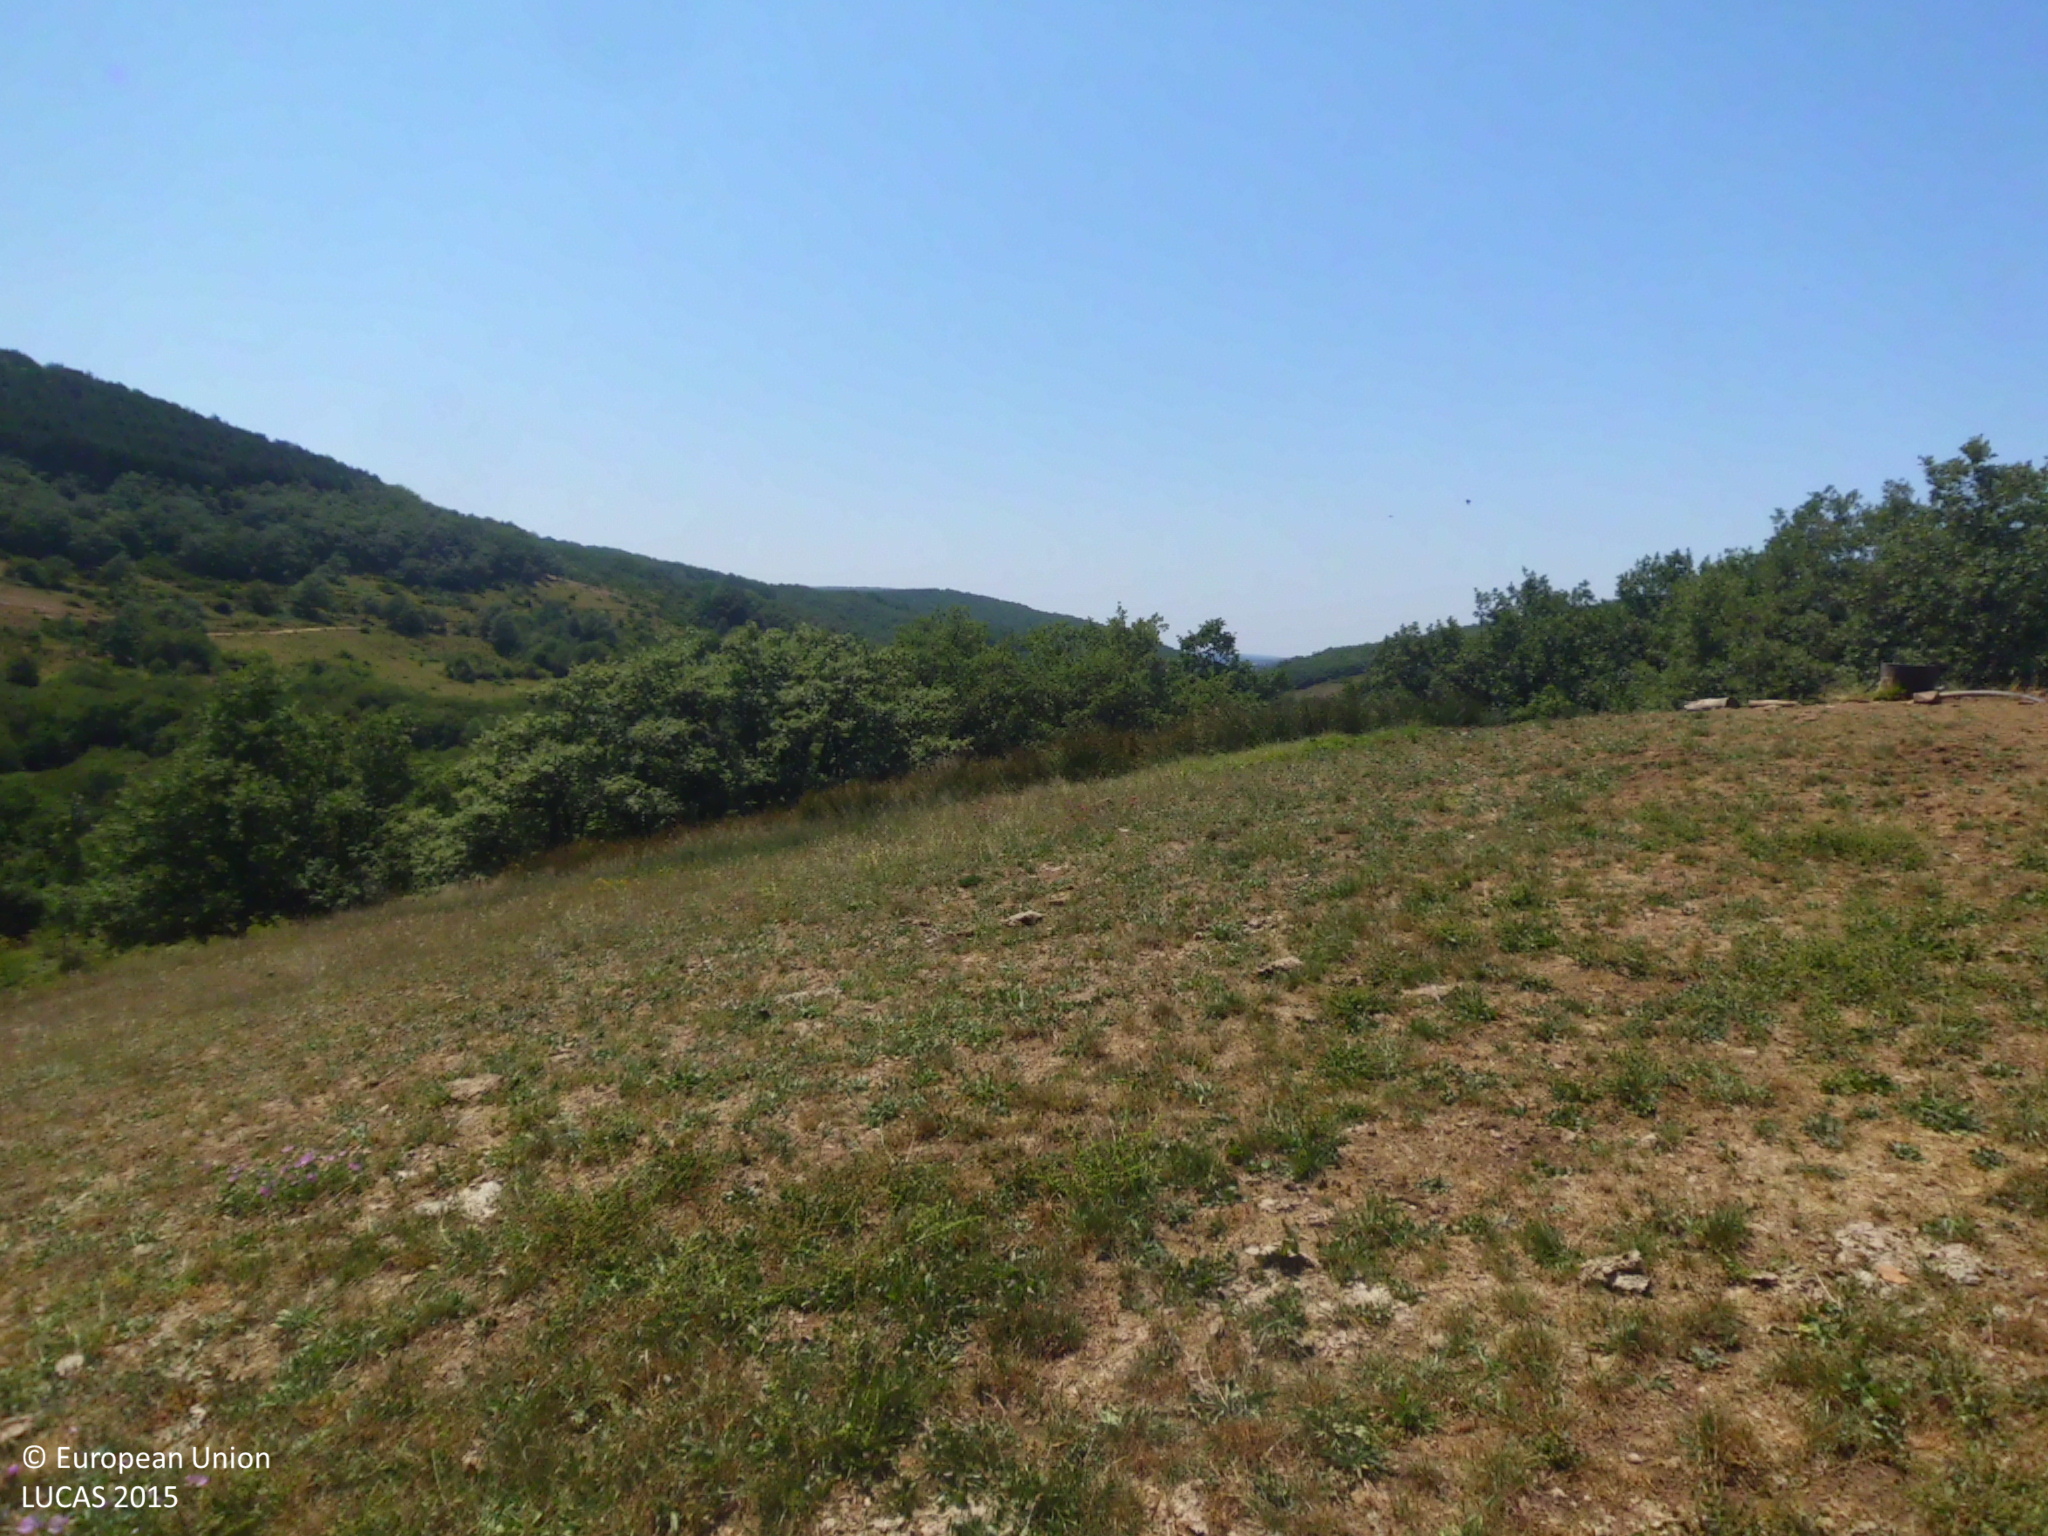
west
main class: Grassland
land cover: Grassland without tree/shrub cover
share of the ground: > 75 %
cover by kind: herbaceous plants 100 %
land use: Agriculture (excluding fallow land and kitchen gardens)
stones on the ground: < 10 %
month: July
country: ES
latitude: 42.3041
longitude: -3.2887
